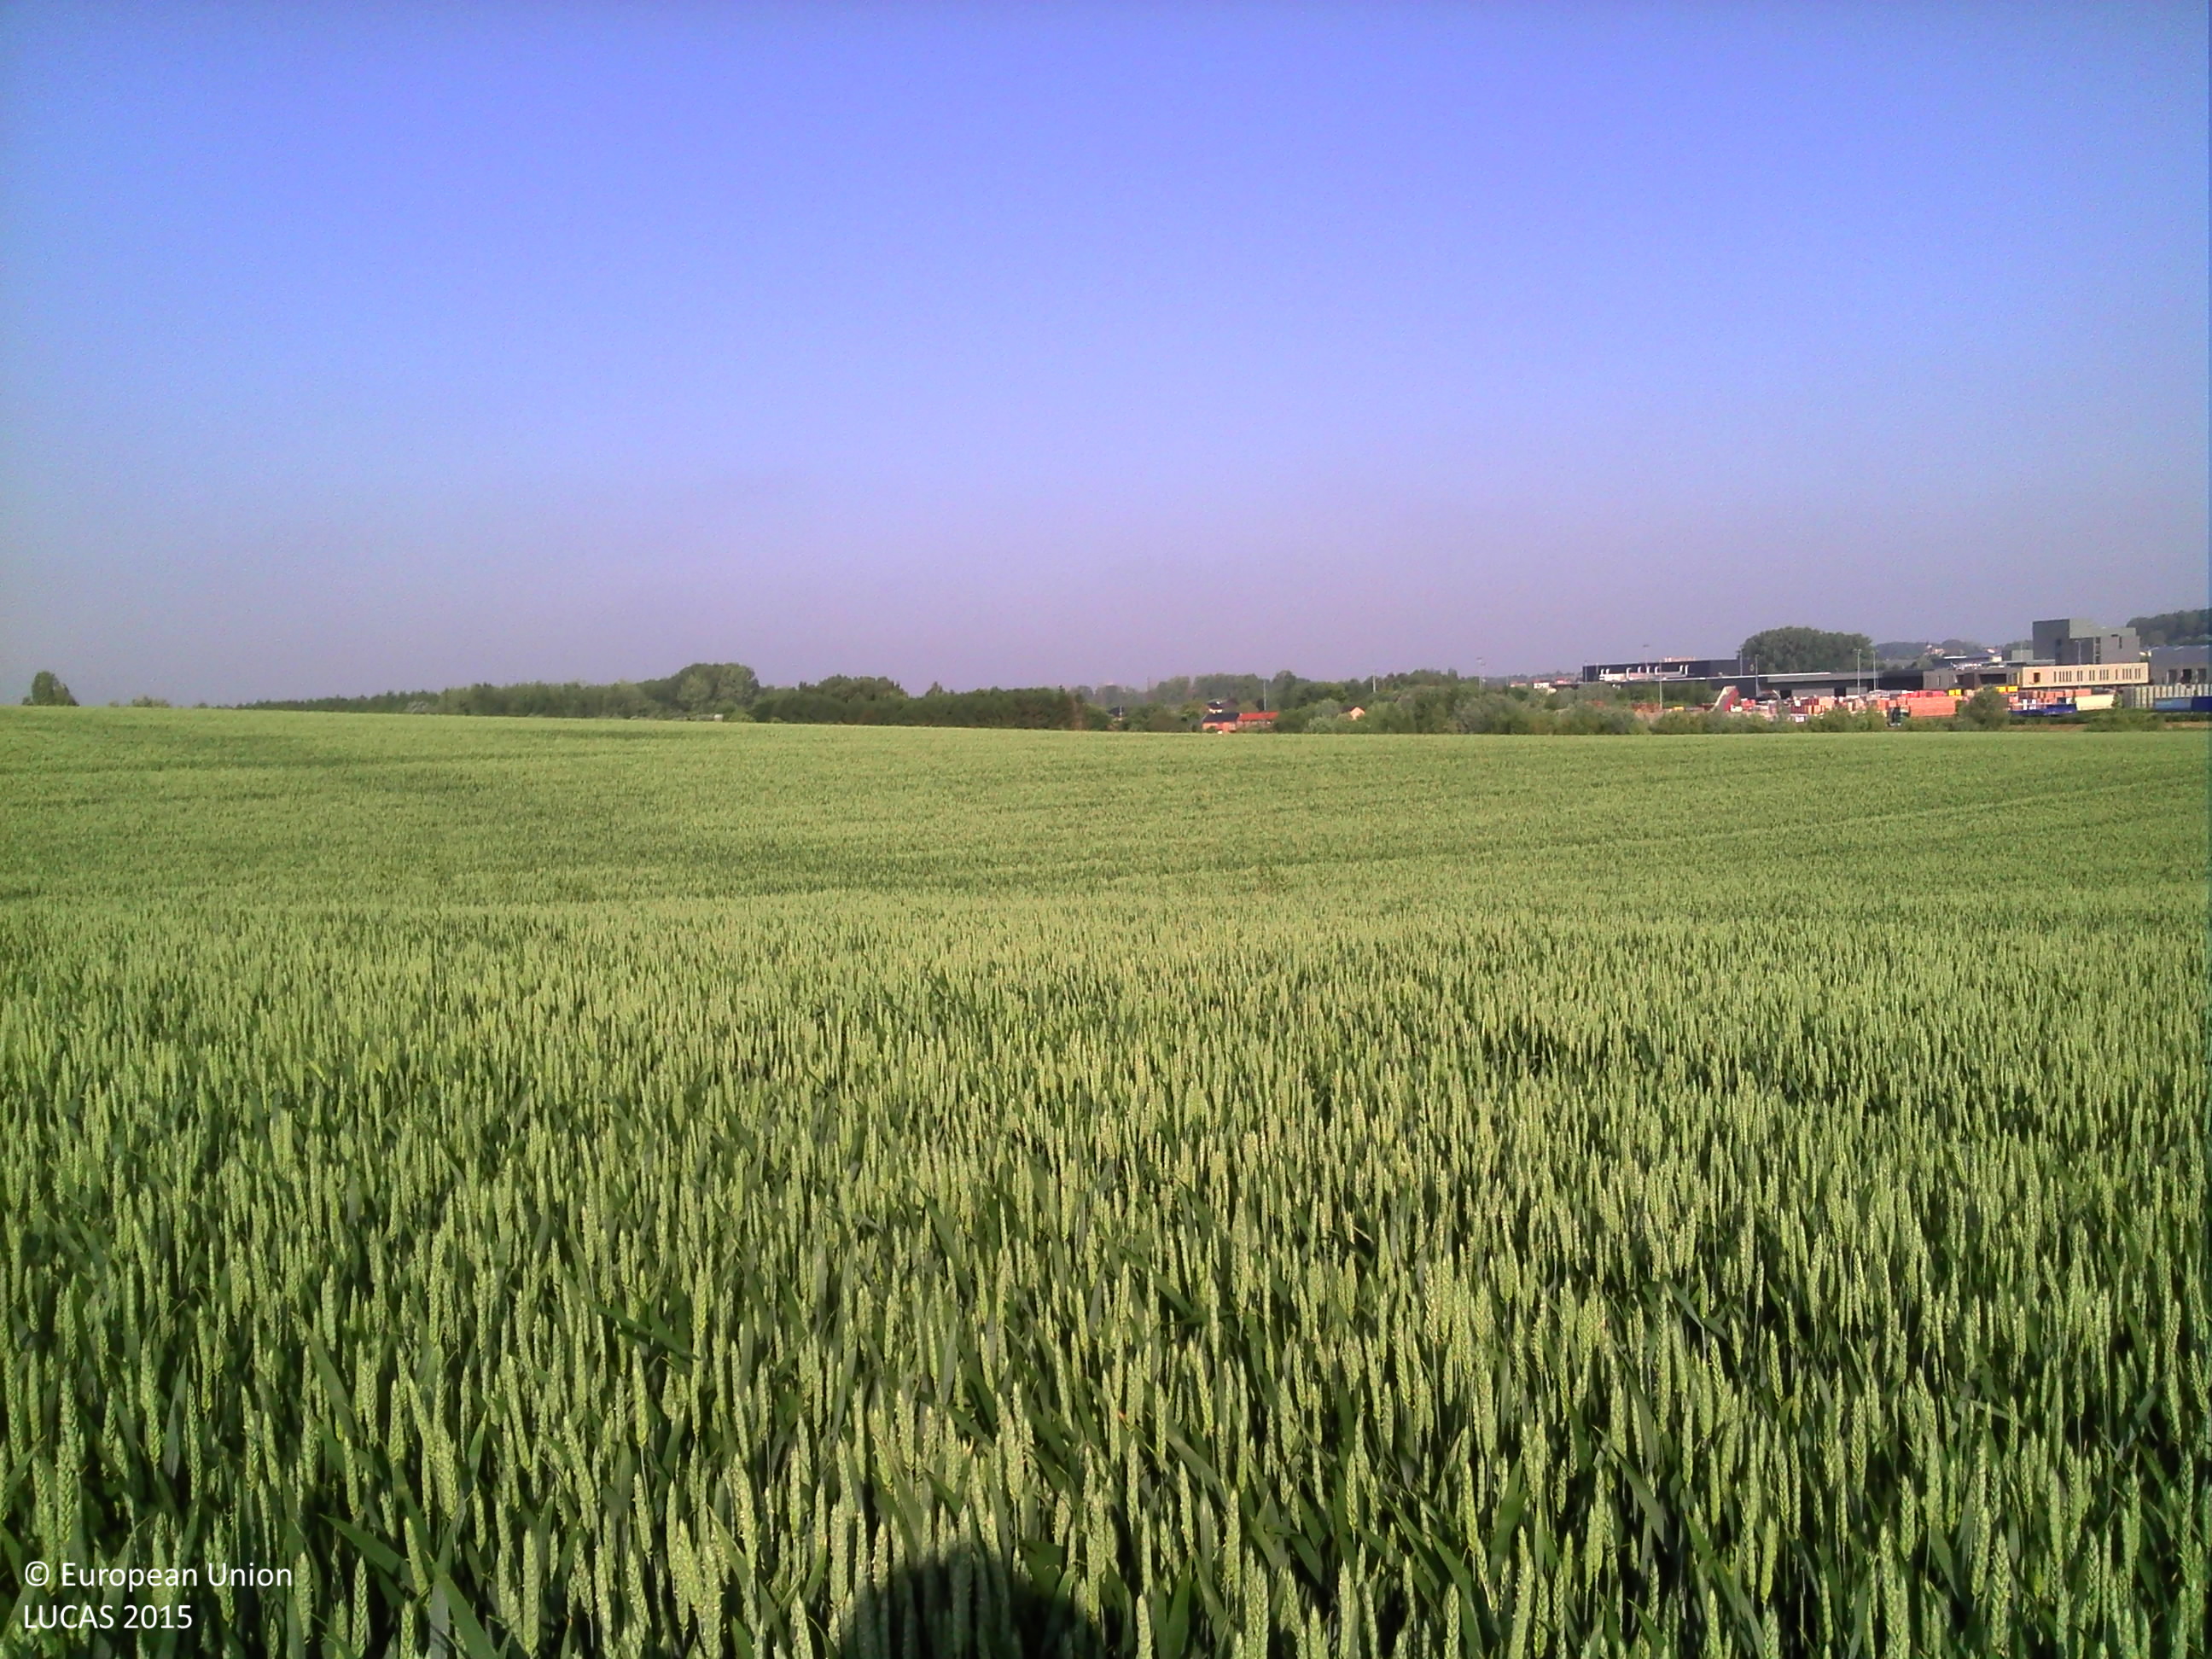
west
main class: Cropland
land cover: Common wheat
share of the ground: > 75 %
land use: Agriculture (excluding fallow land and kitchen gardens)
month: June
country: BE
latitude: 50.7810
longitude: 5.5306
